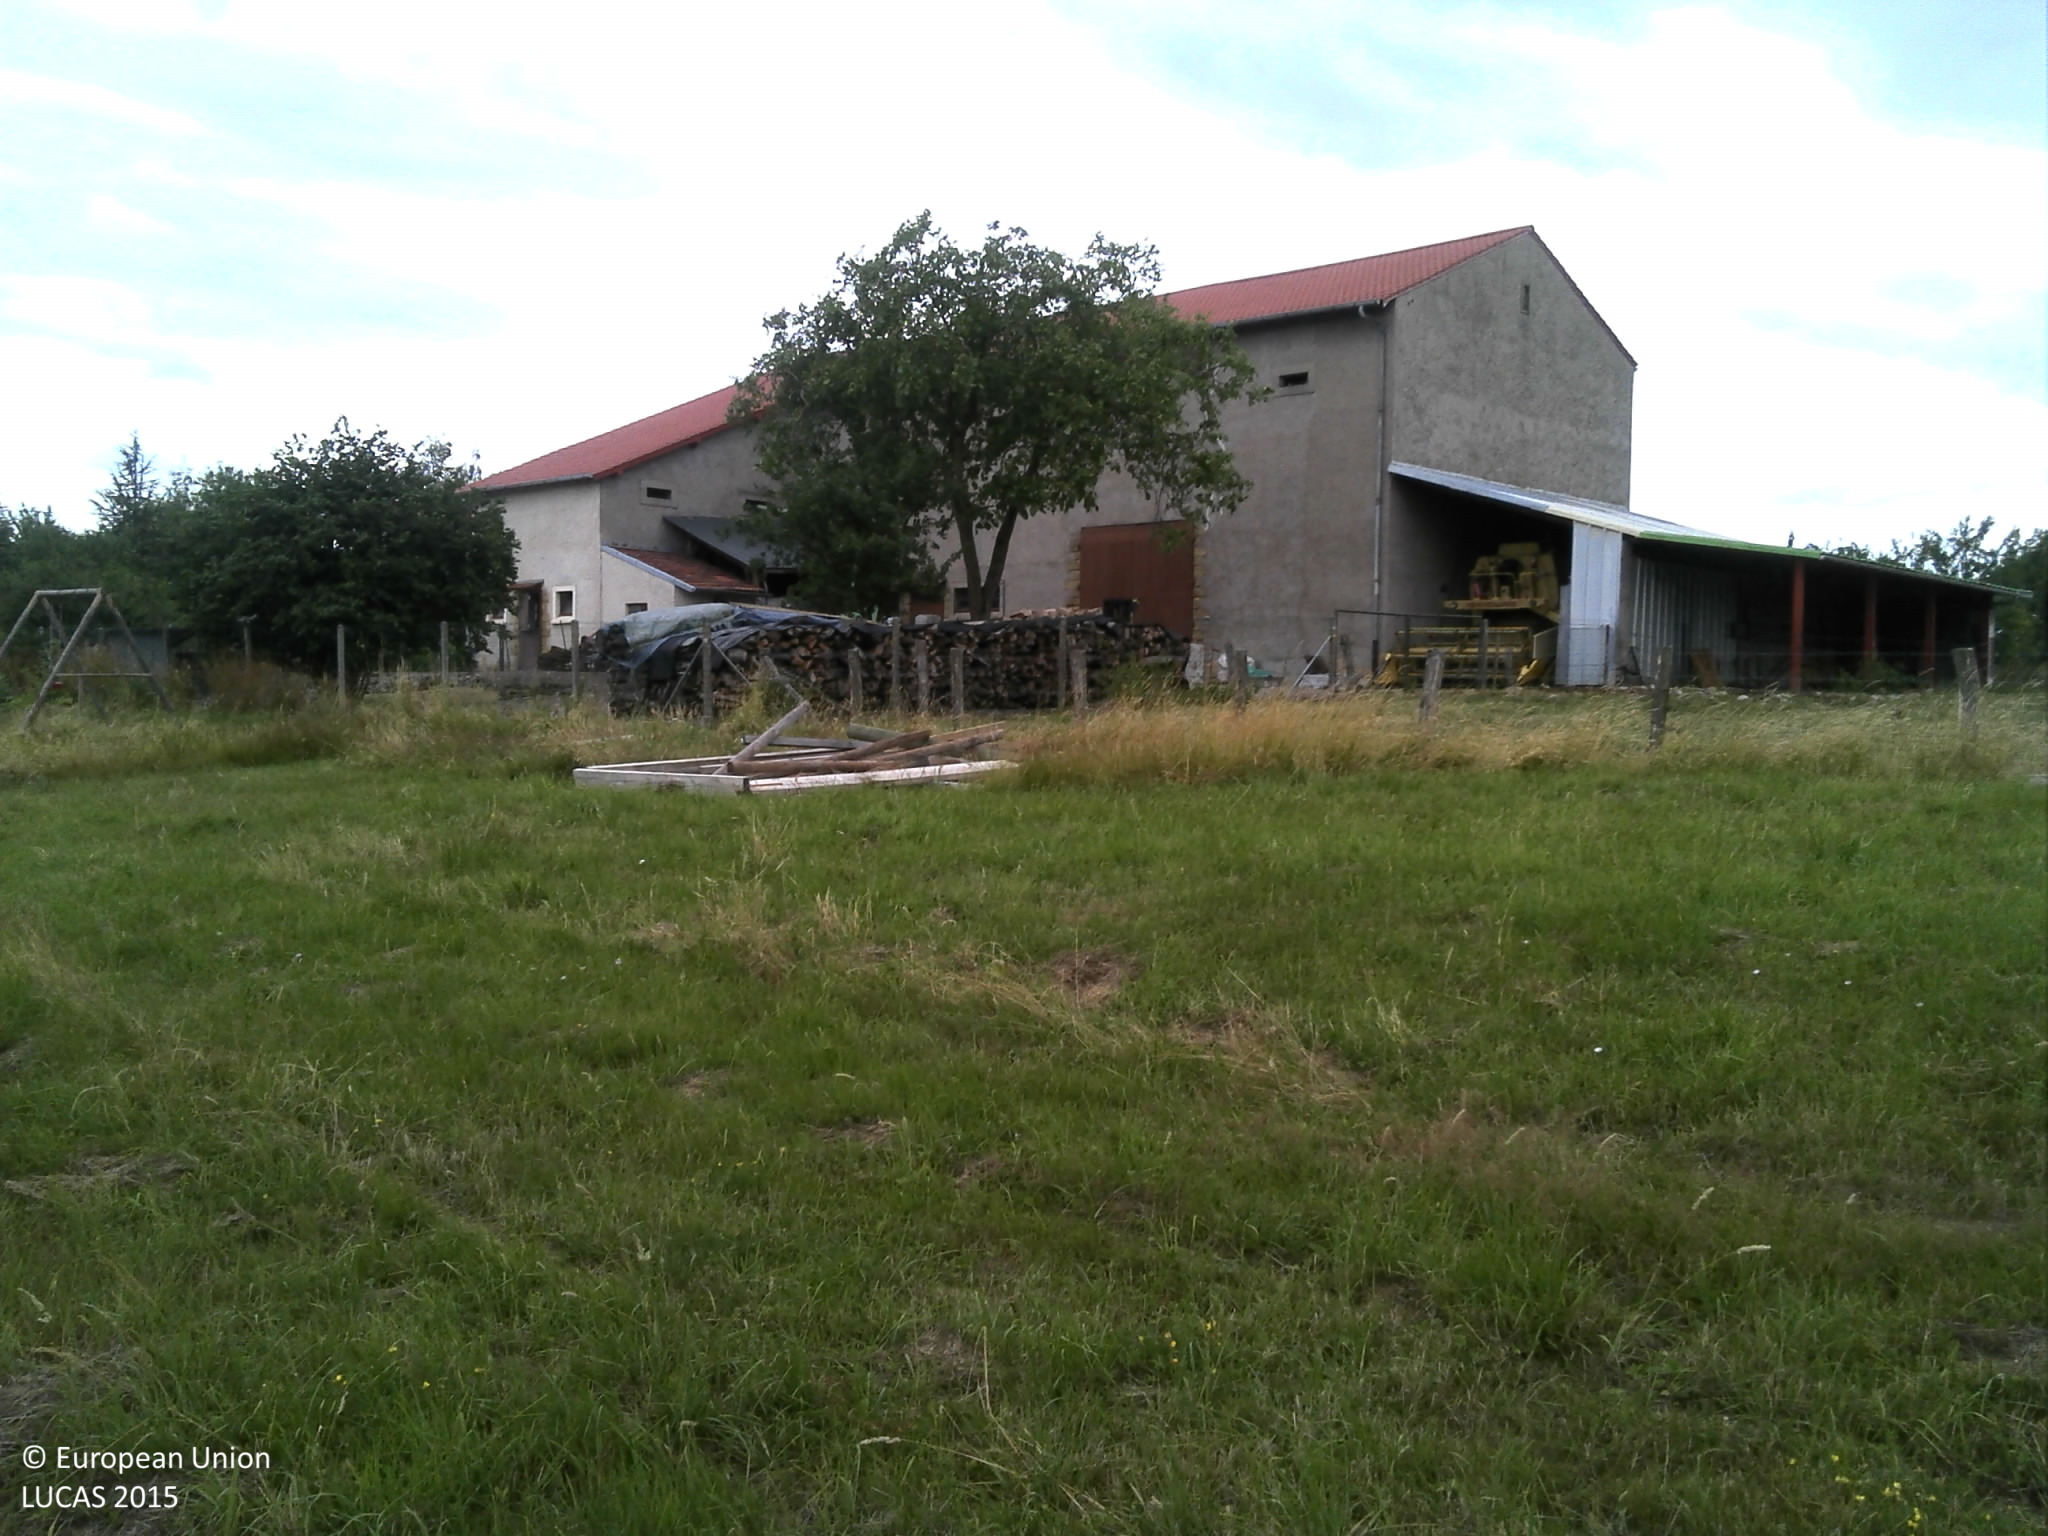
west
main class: Grassland
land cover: Grassland without tree/shrub cover
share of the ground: > 75 %
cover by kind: herbaceous plants 100 %
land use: Residential
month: July
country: FR
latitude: 49.3553
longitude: 6.4617
